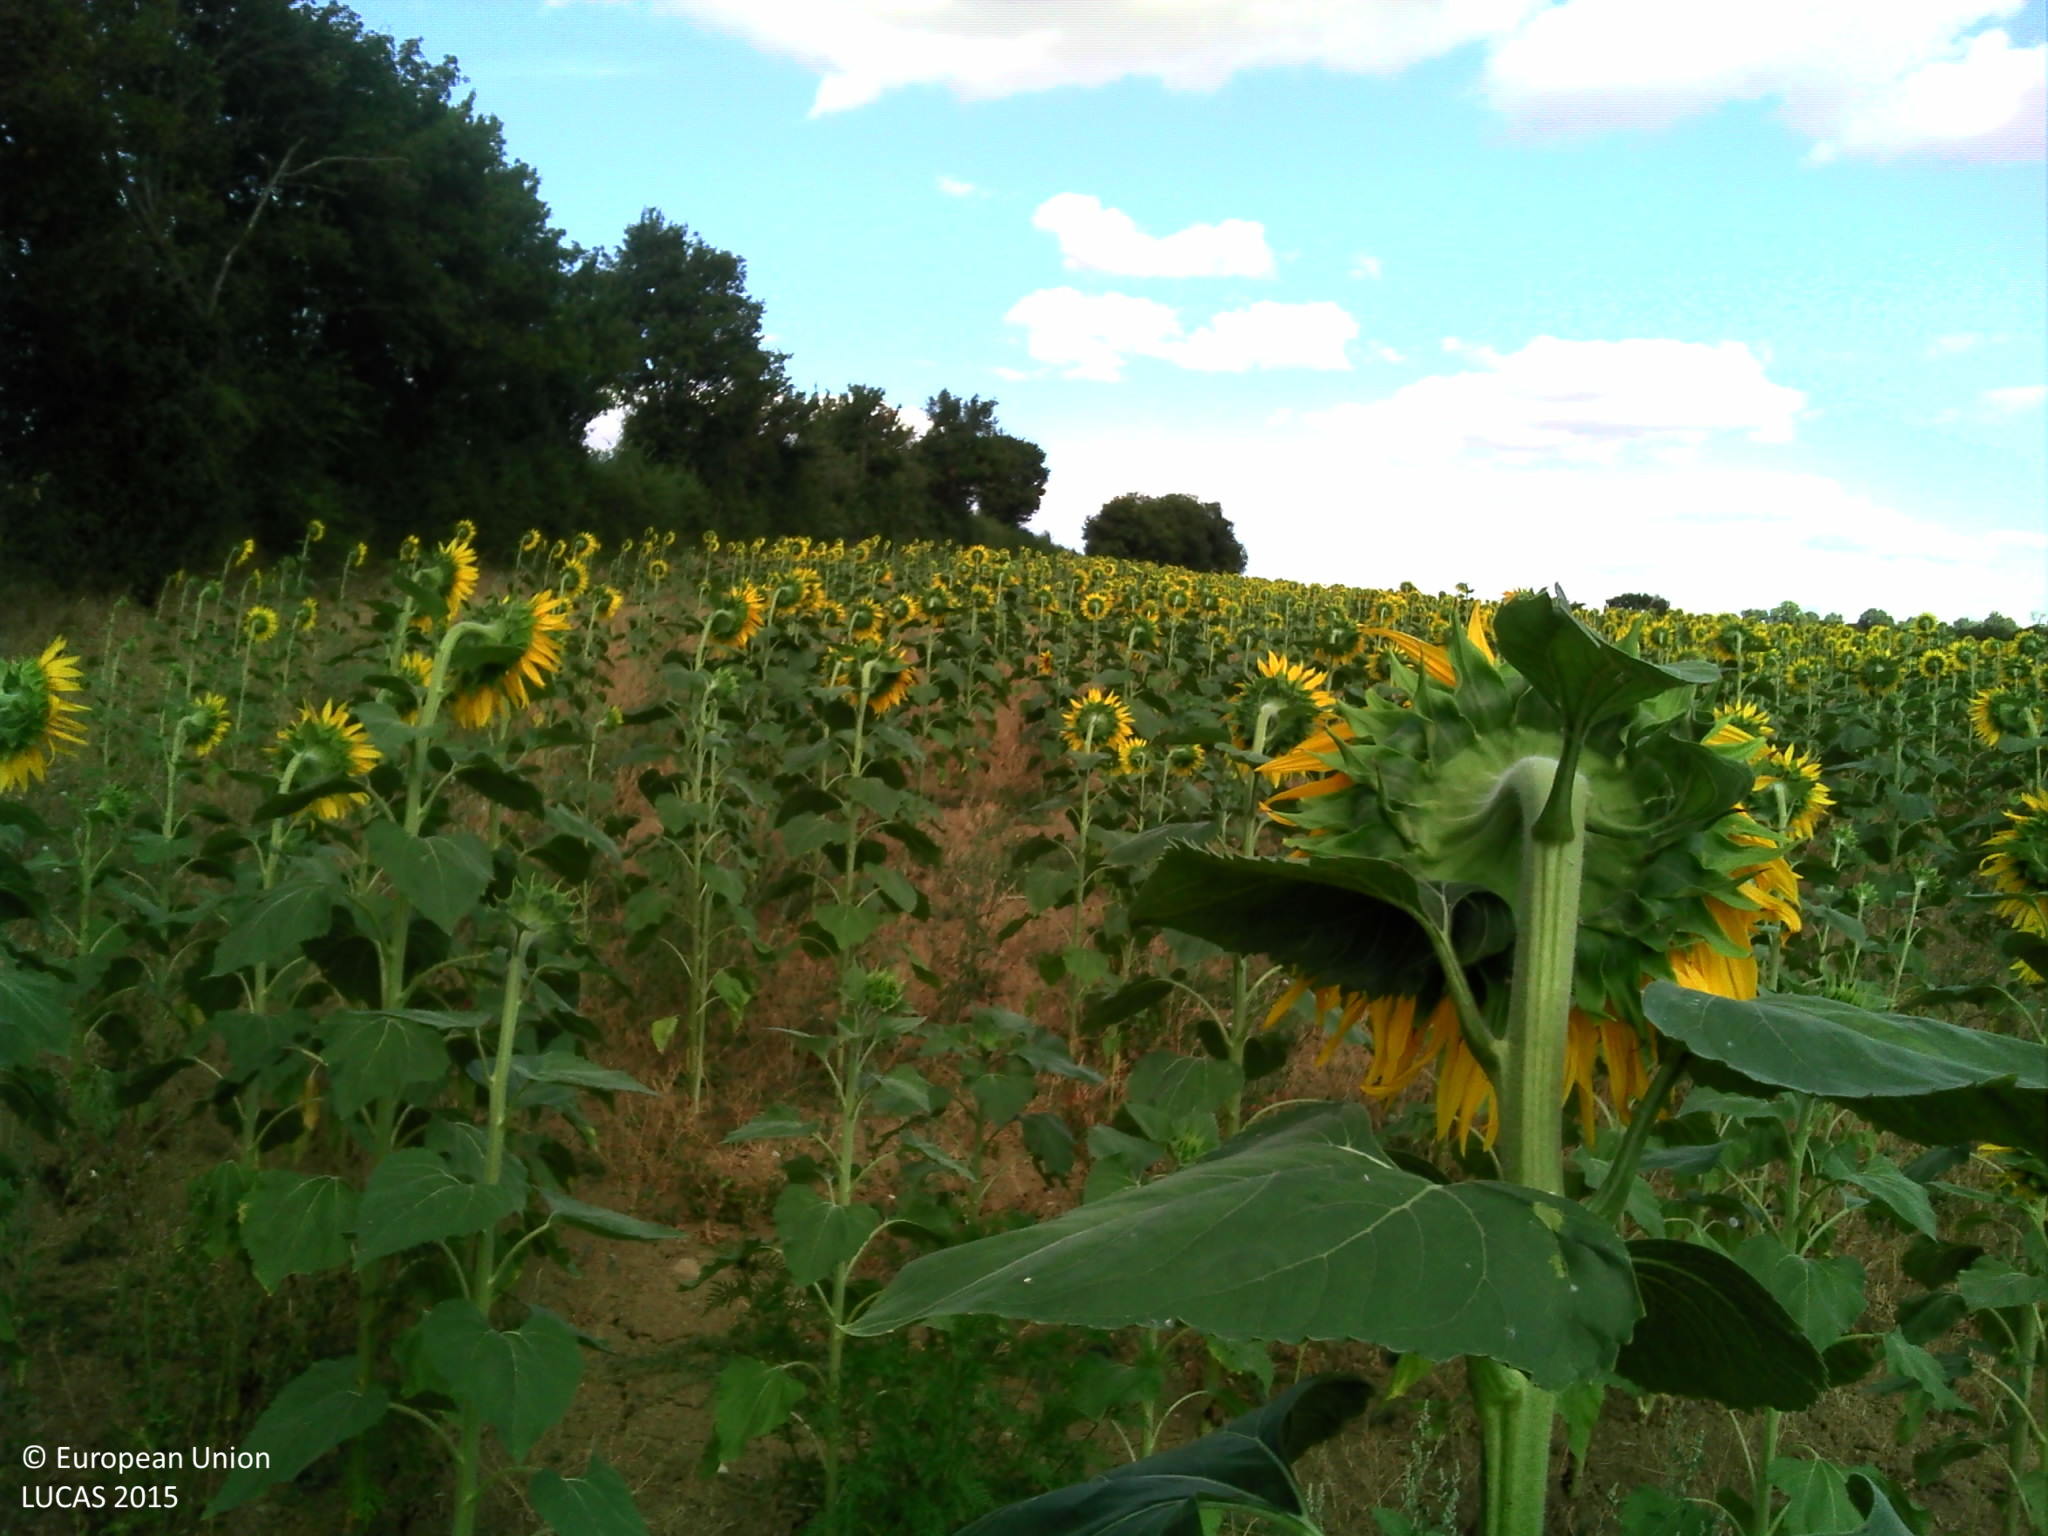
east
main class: Cropland
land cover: Sunflower
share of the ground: 50 - 75 %
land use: Agriculture (excluding fallow land and kitchen gardens)
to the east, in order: Sunflower; Abandoned hedges; Barley
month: July
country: FR
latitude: 46.6445
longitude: 2.1934
